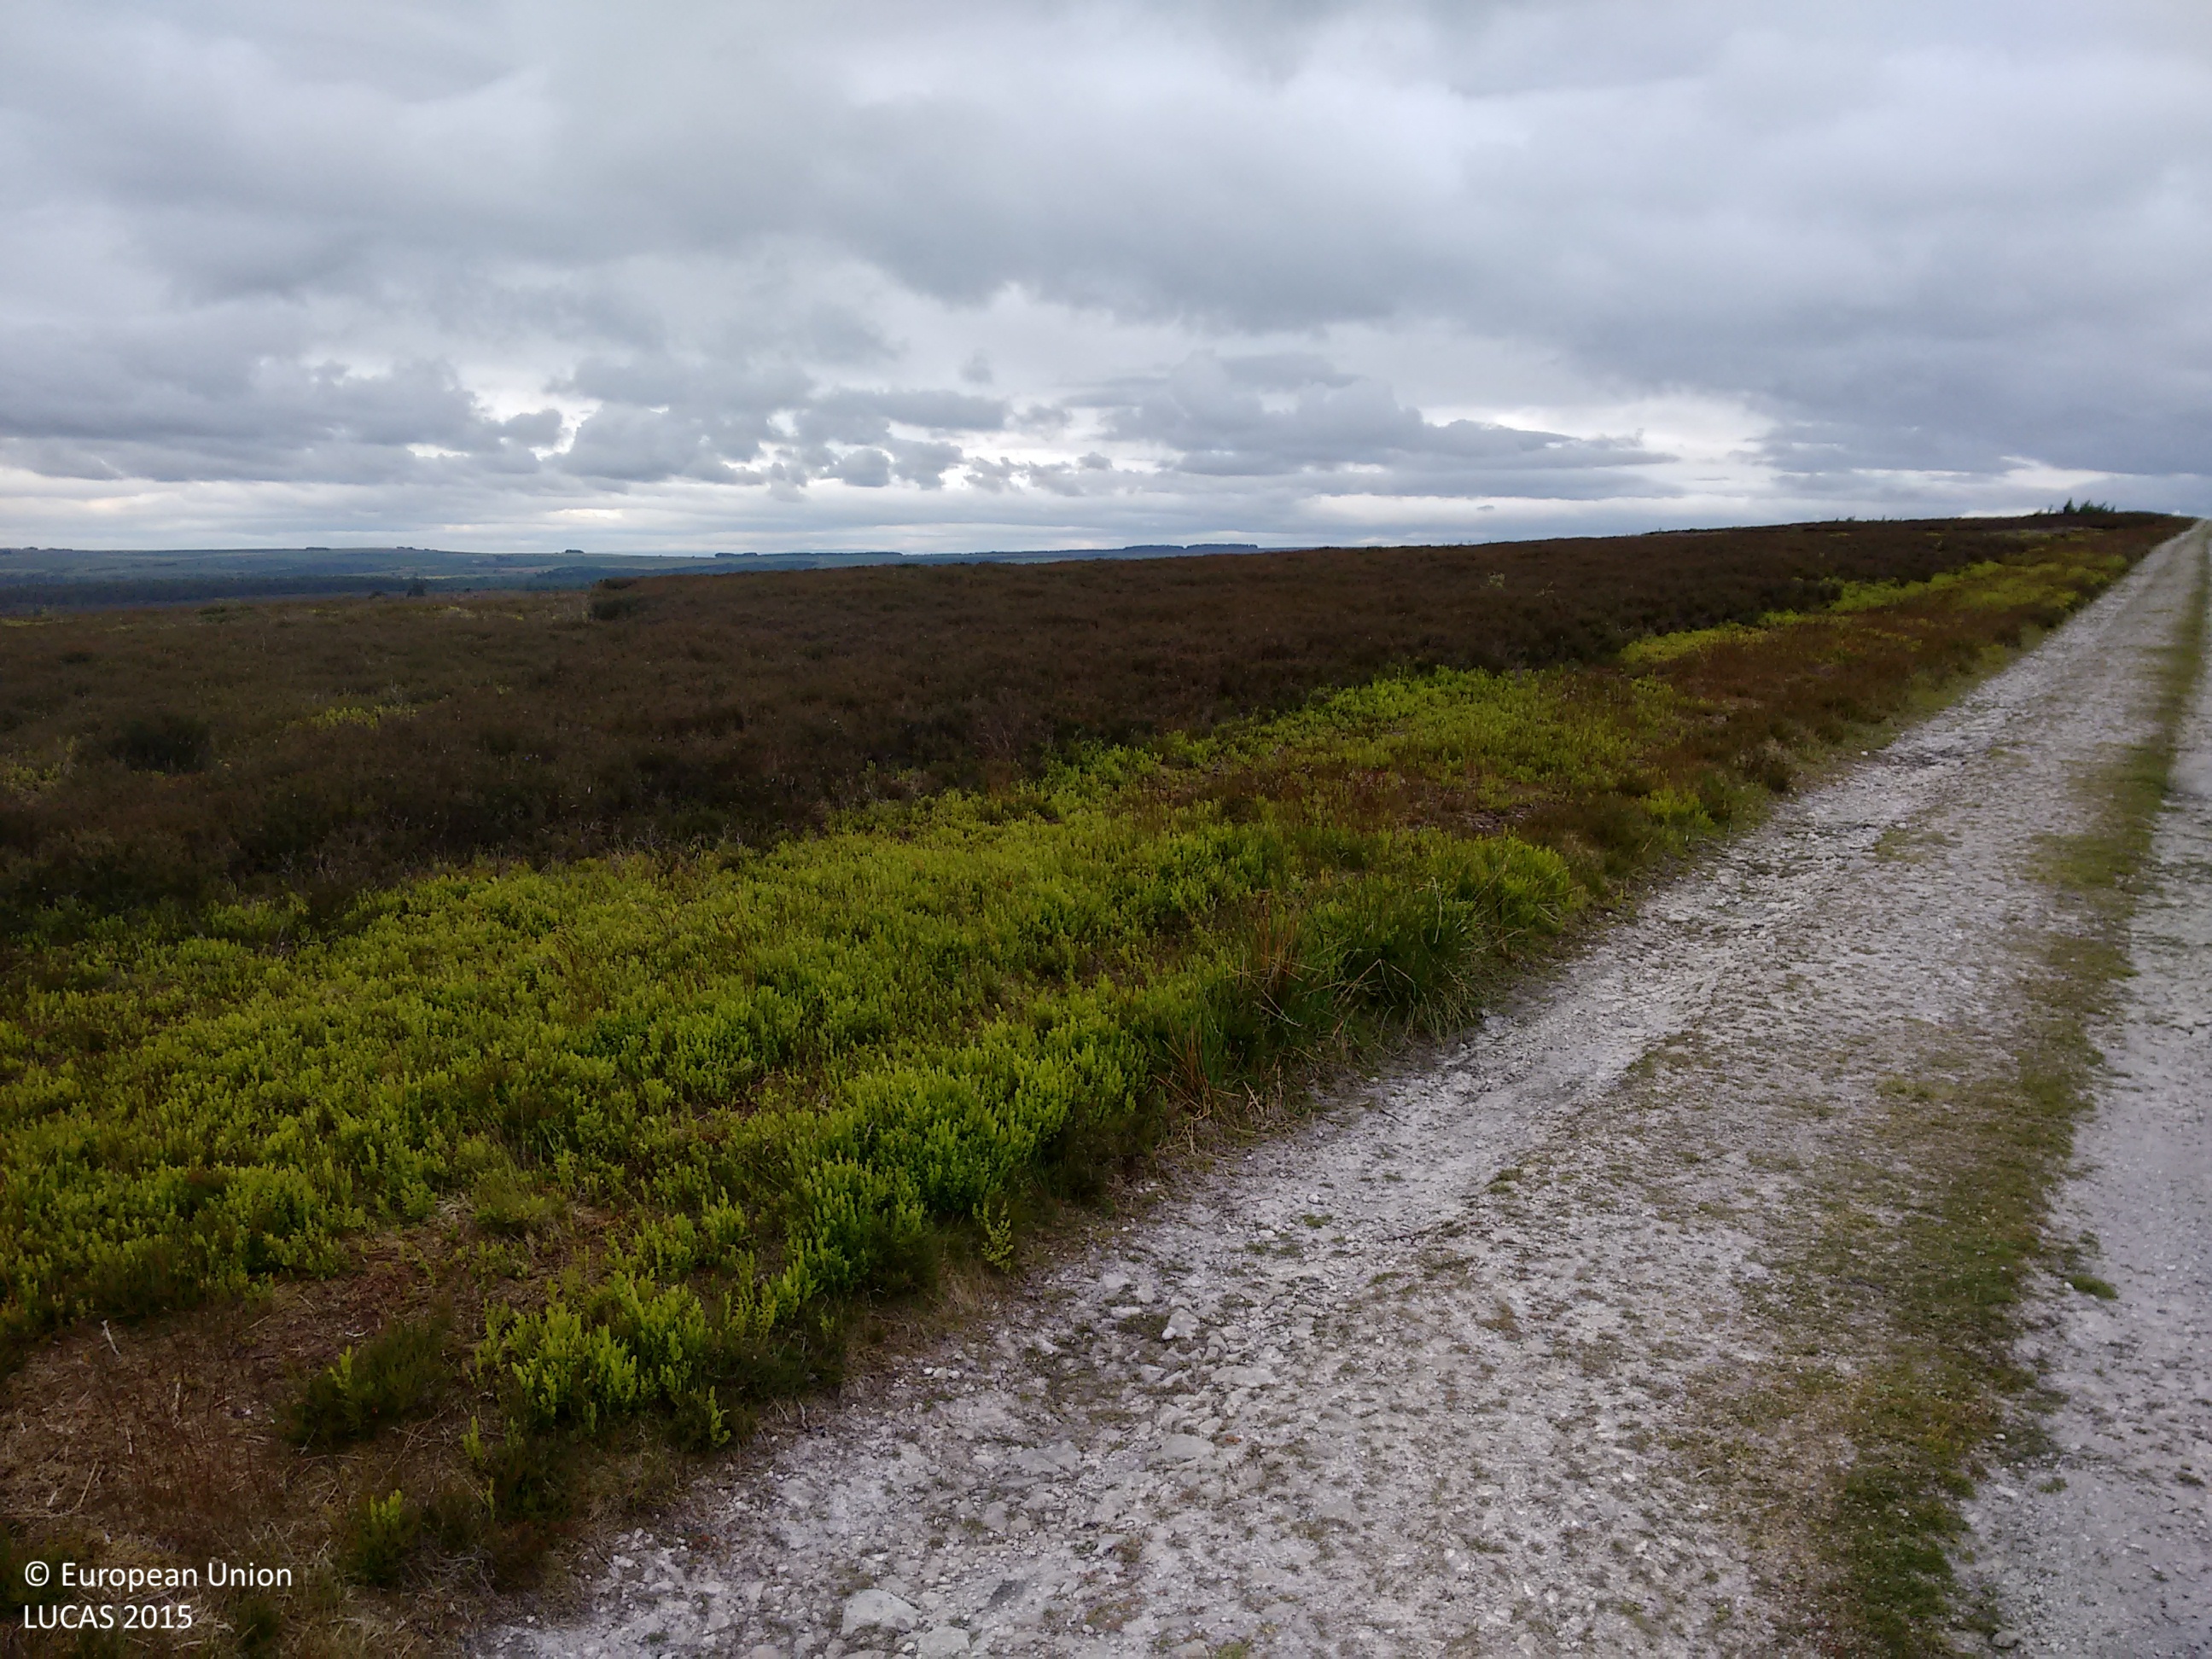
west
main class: Shrubland
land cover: Shrubland without tree cover
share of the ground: > 75 %
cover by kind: shrubs 100 %
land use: Semi-natural and natural areas not in use
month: June
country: GB
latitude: 54.3067
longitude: -1.0936
